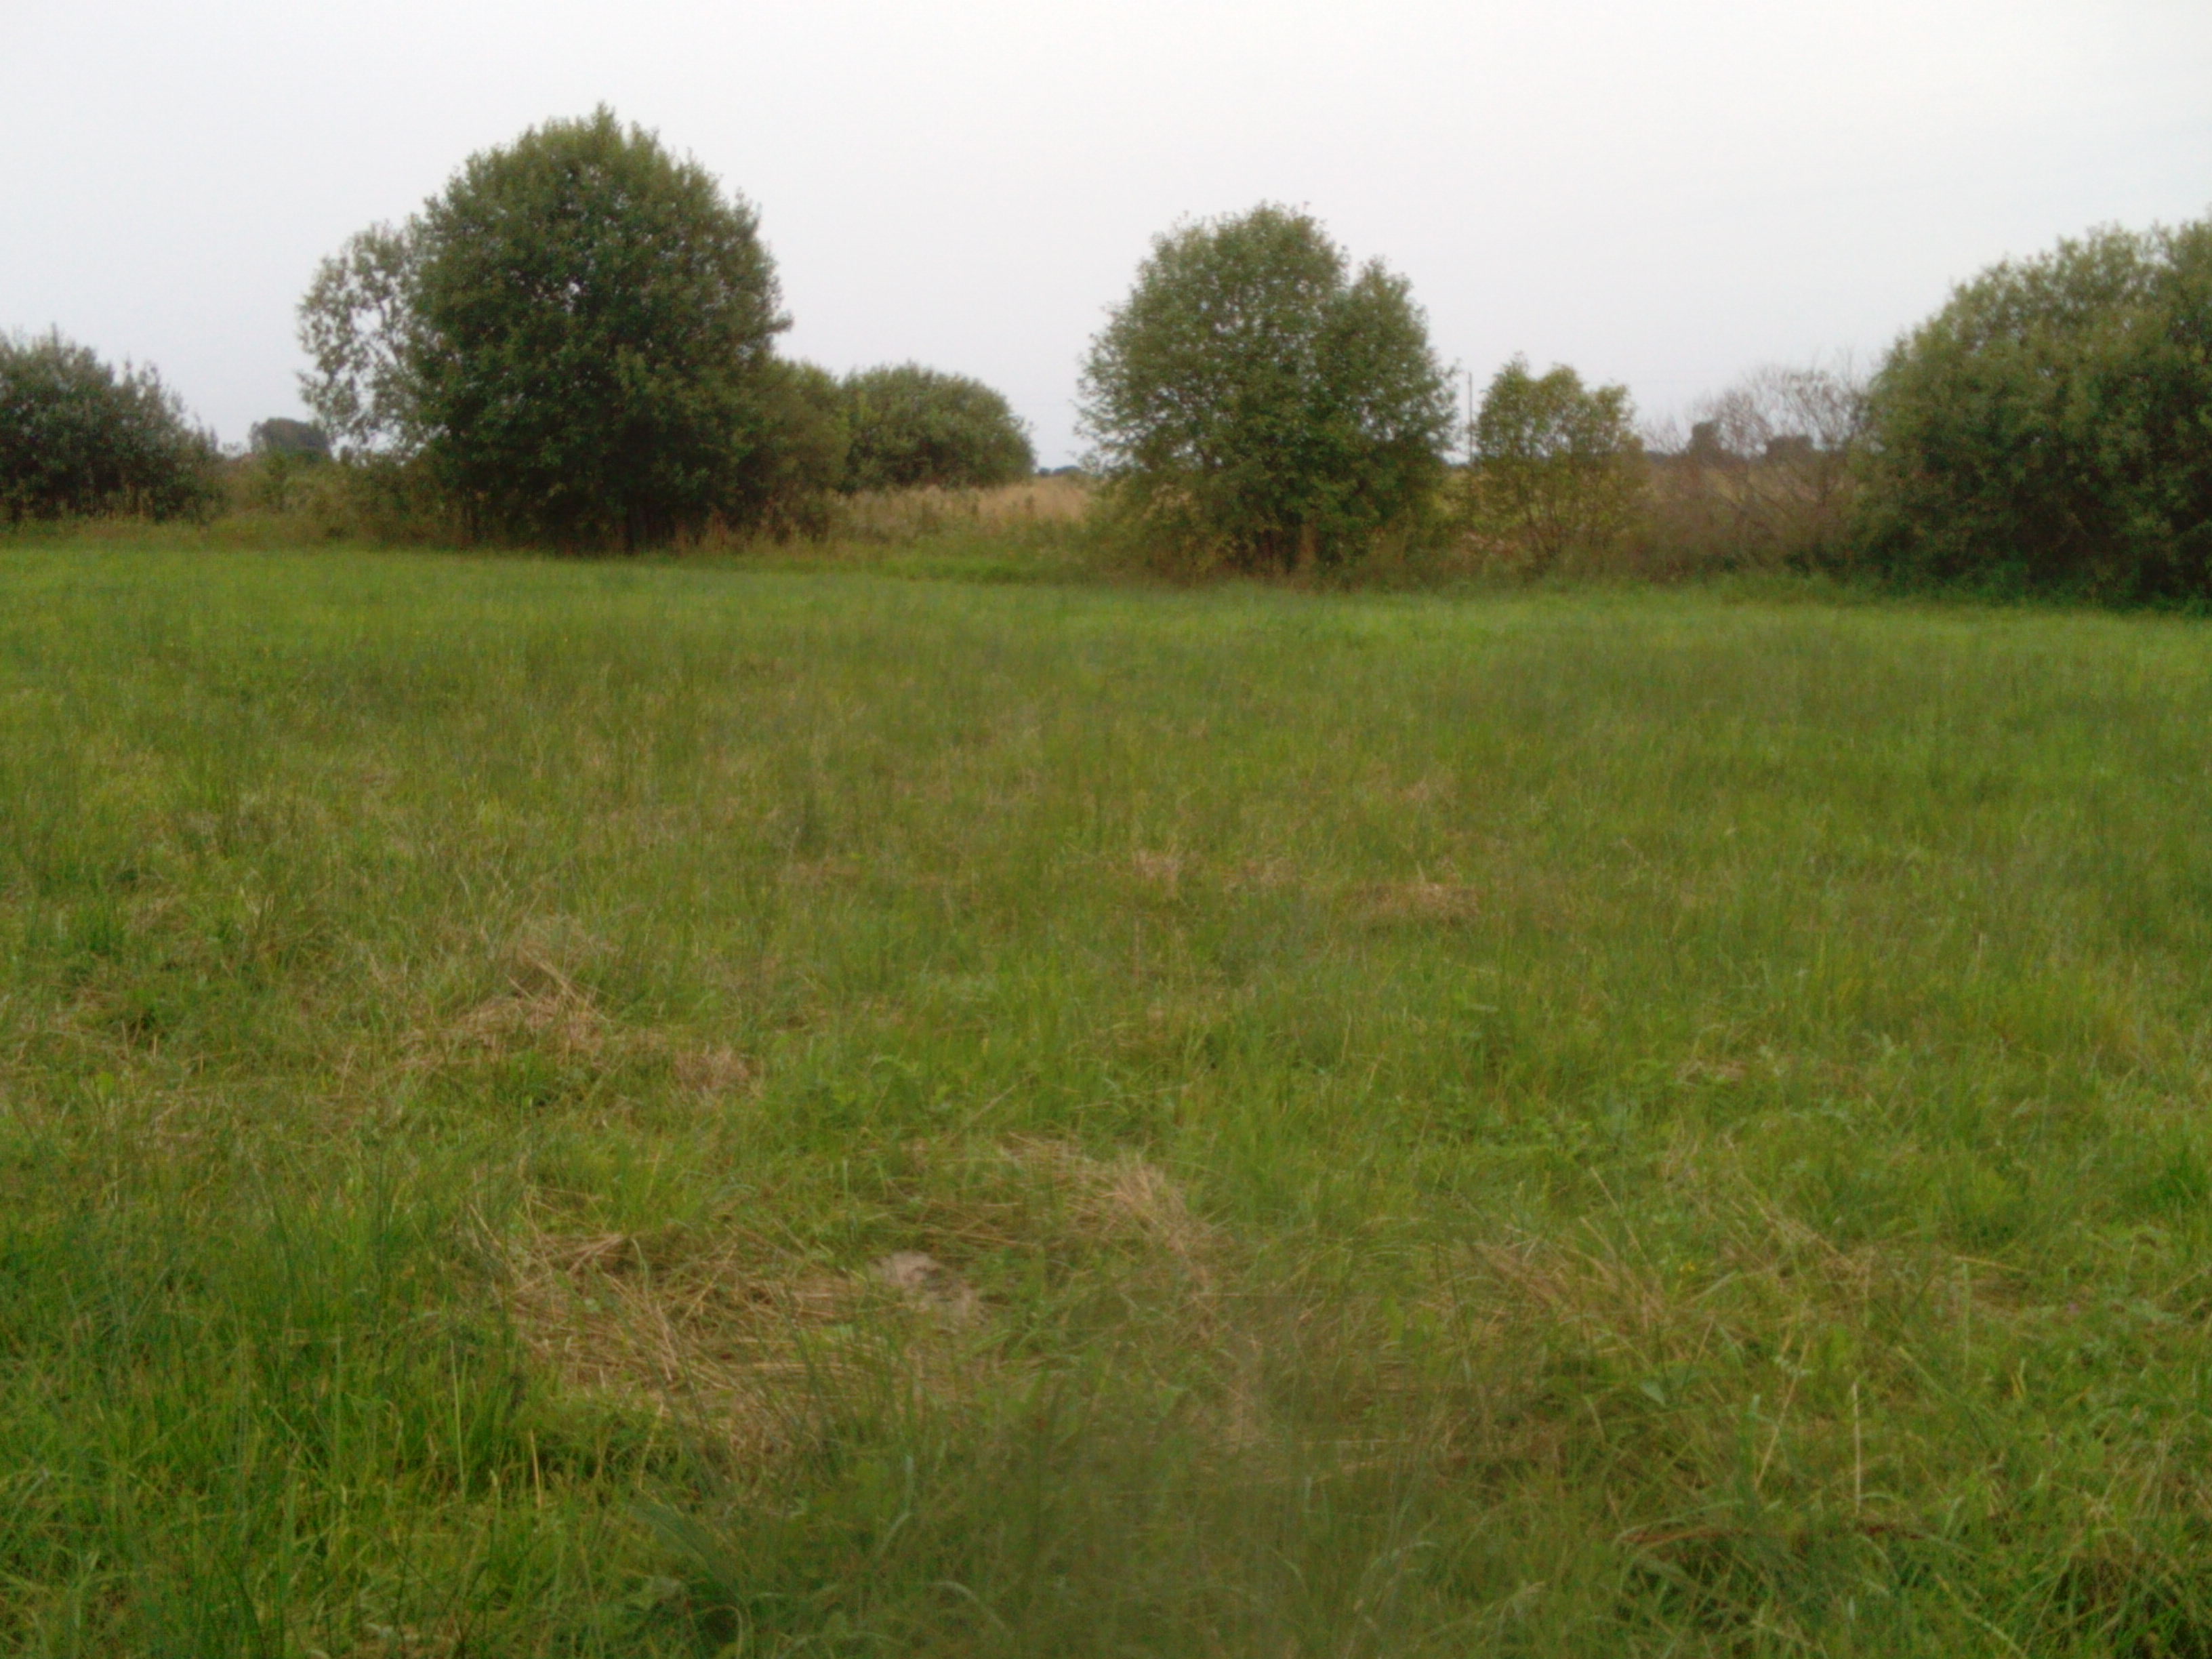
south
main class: Grassland
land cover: Grassland without tree/shrub cover
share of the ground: > 75 %
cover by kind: herbaceous plants 100 %
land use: Agriculture (excluding fallow land and kitchen gardens)
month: September
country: LT
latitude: 55.7156
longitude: 22.7187
